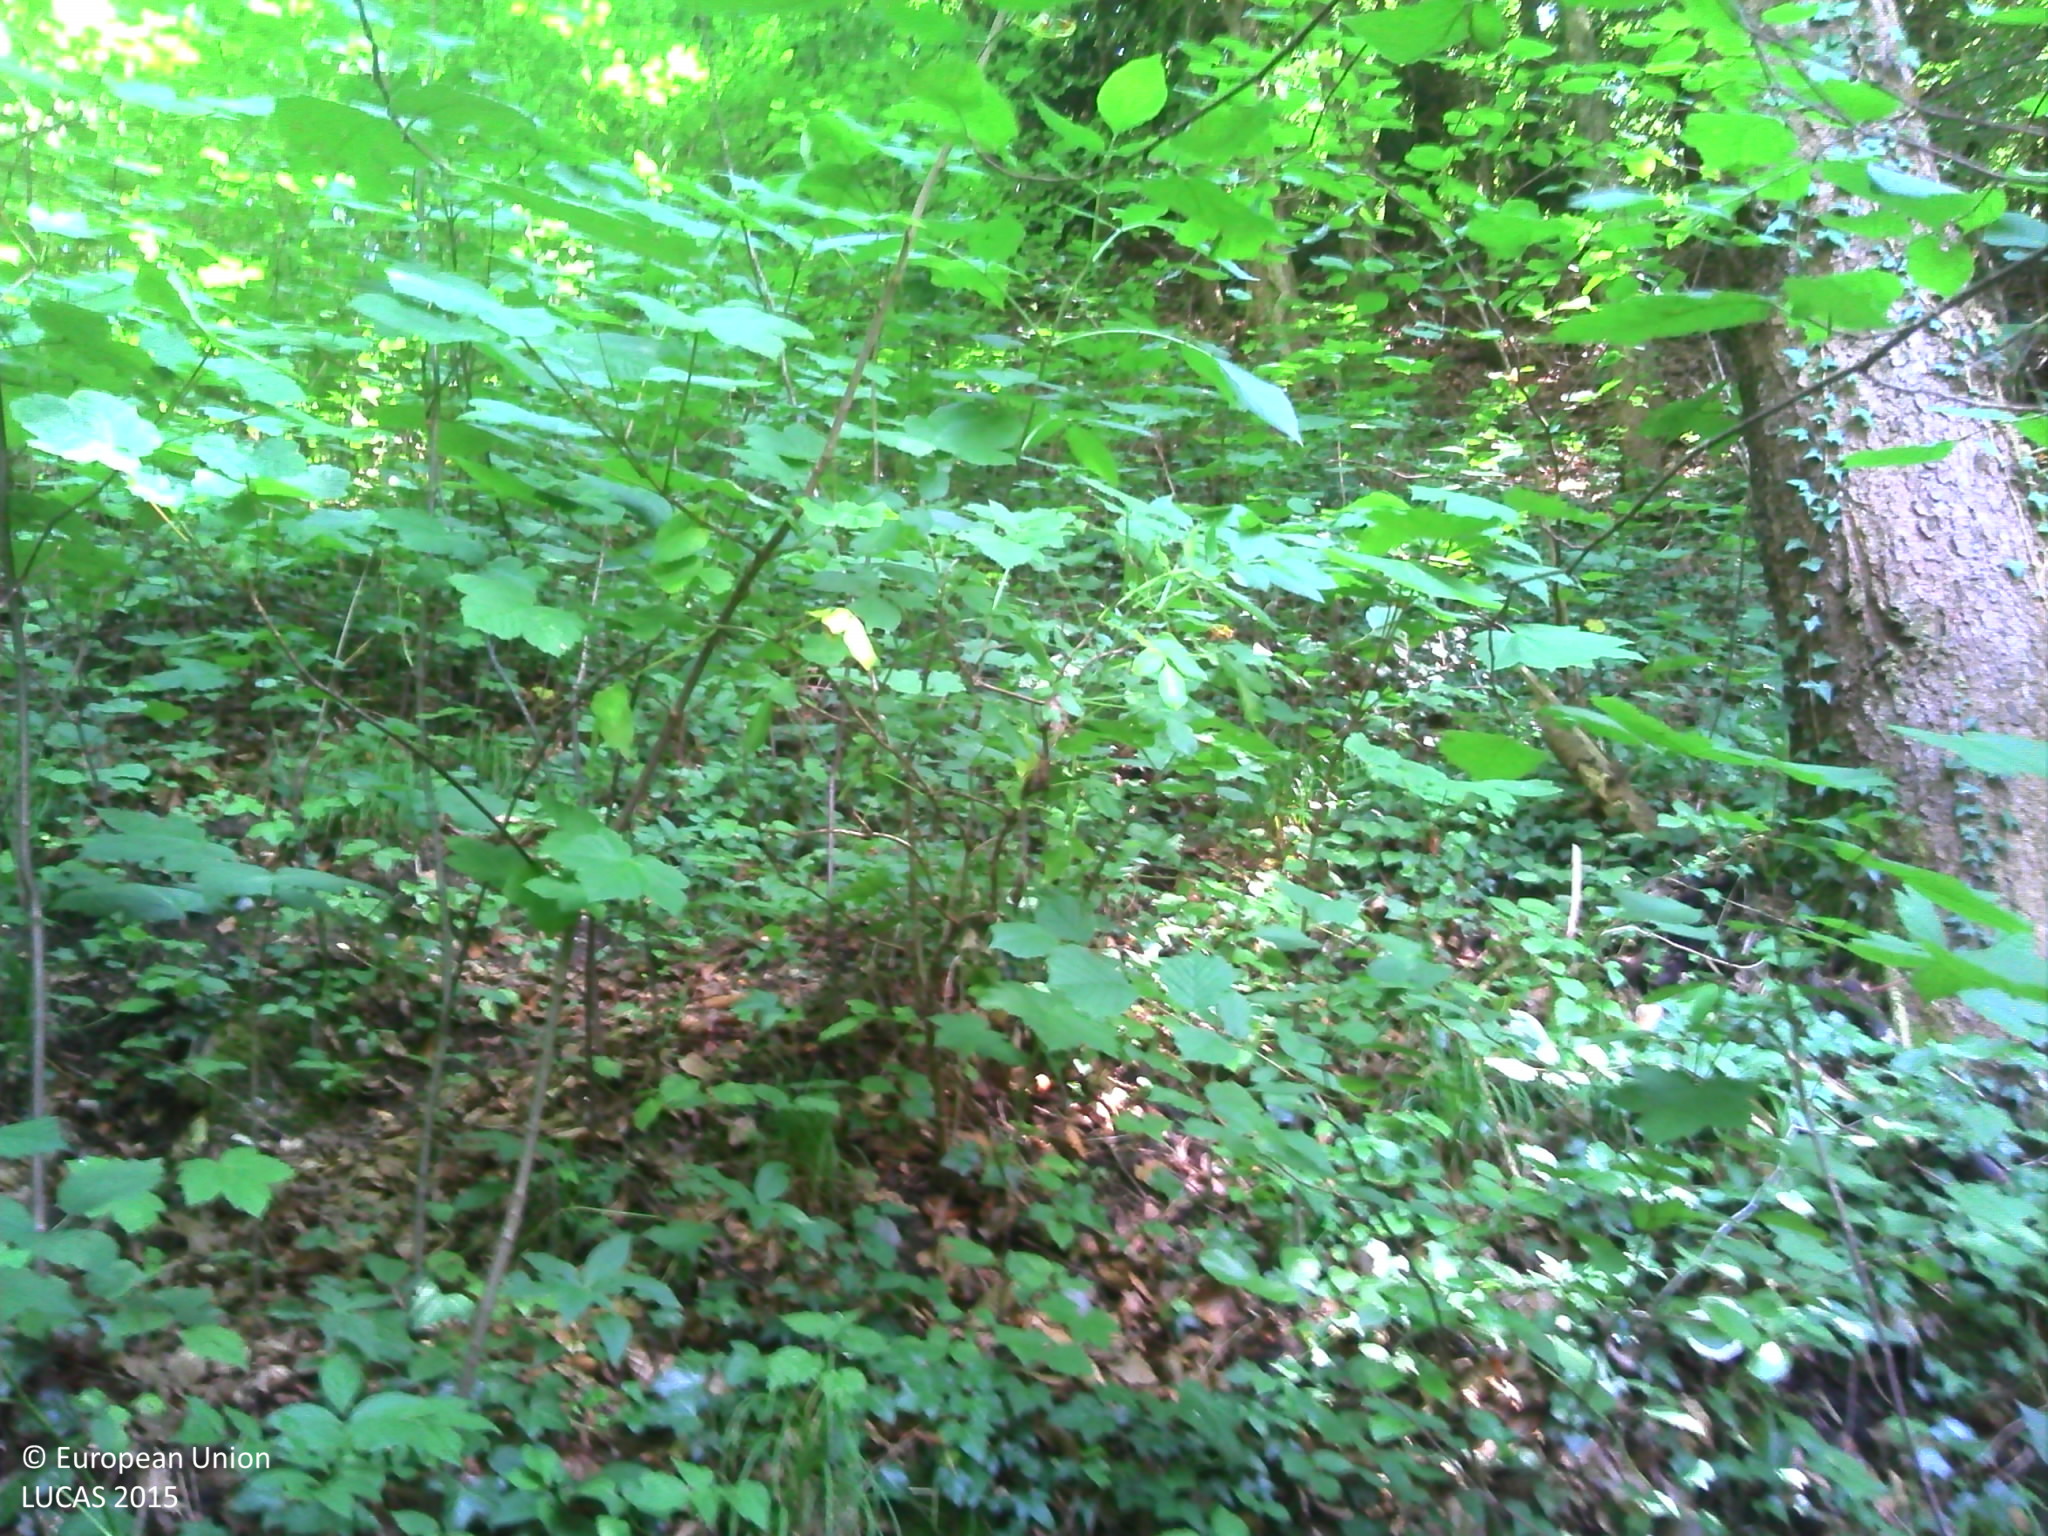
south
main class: Woodland
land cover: Spruce dominated mixed woodland
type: mountainous beech forest
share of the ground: > 75 %
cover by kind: broadleaved forest trees 40 %, coniferous forest trees 35 %, herbaceous plants 20 %, lichens and mosses 5 %
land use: Forestry
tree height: > 5 m
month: July
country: FR
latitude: 45.9562
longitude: 6.1203
